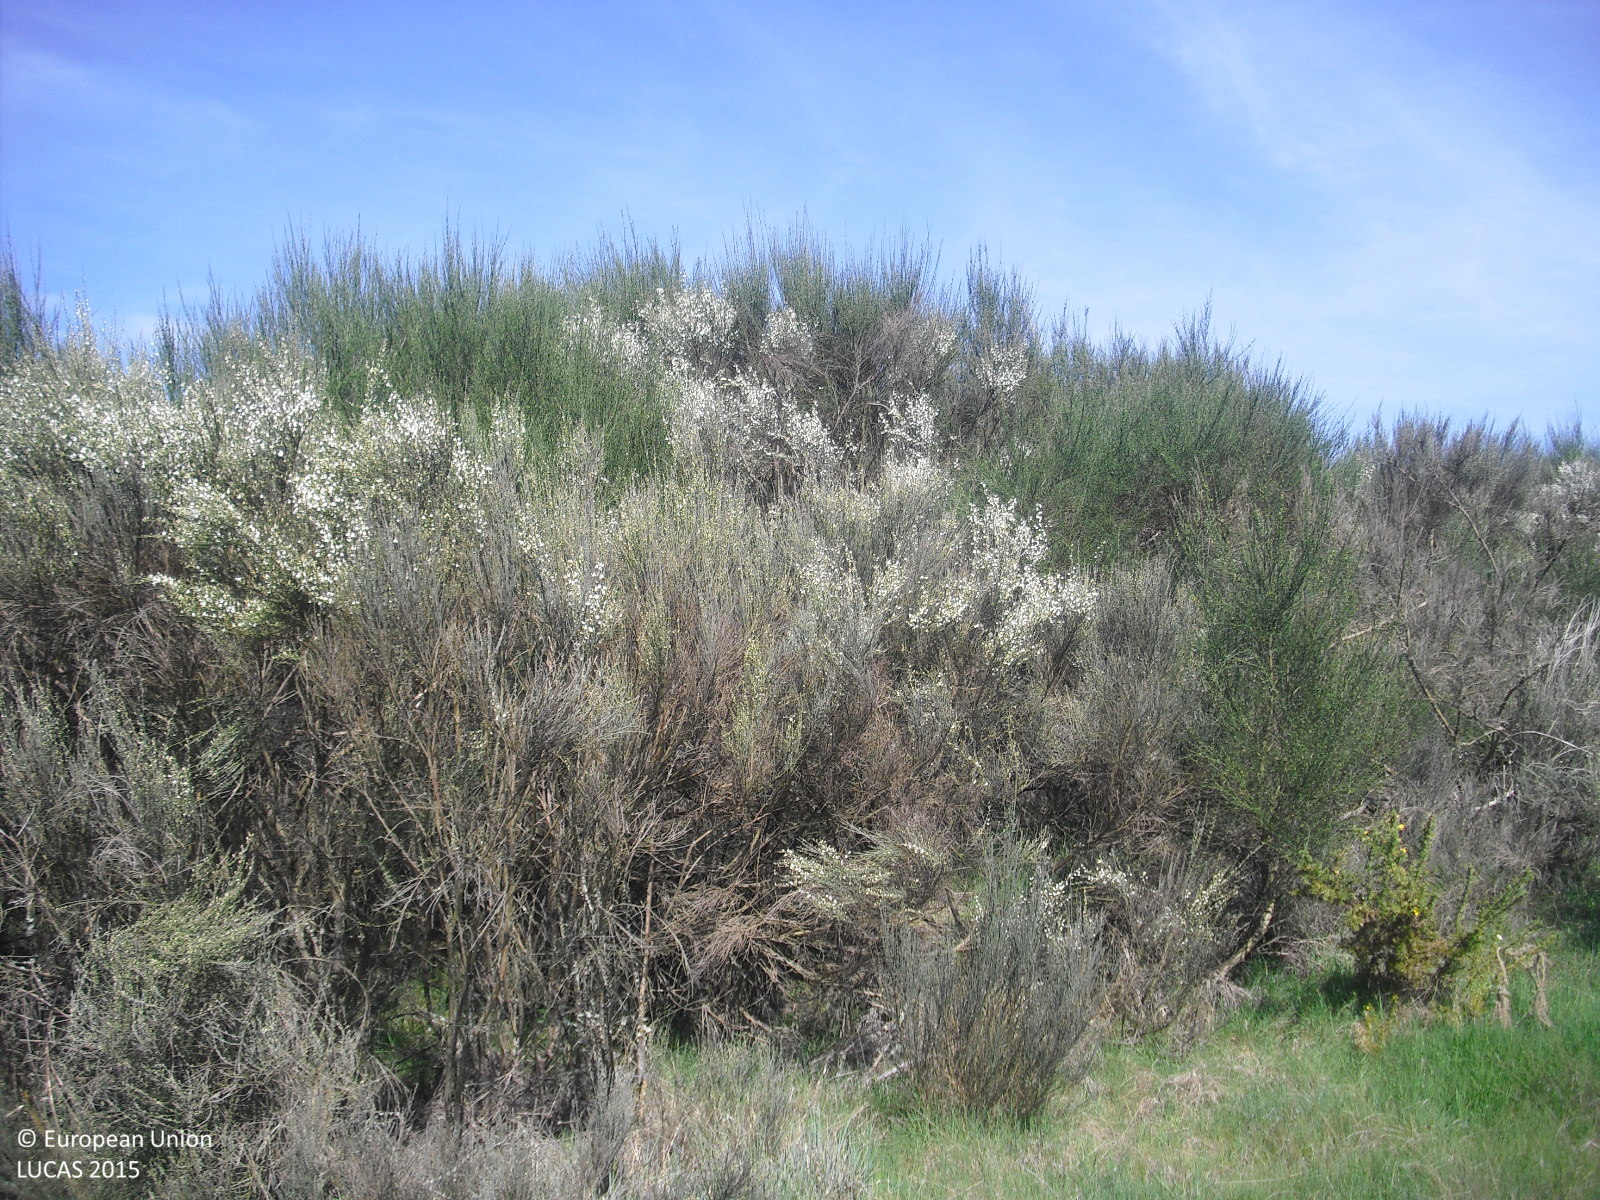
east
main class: Artificial land
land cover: Non built-up linear features
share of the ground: > 75 %
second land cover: Grassland without tree/shrub cover
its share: > 75 %
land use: Road transport
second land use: Agriculture (excluding fallow land and kitchen gardens)
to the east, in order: Tracks; Grassland without tree/shrub cover; Shrubland without tree cover; Ditches and canals; Shrubland without tree cover; Dry stone walls; Shrubland without tree cover; Shrubland with sparse tree cover; Shrubland without tree cover; Dry stone walls; Shrubland without tree cover; Tracks; Rock outcrops; Shrubland without tree cover
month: April
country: ES
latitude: 41.9574
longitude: -7.6441
